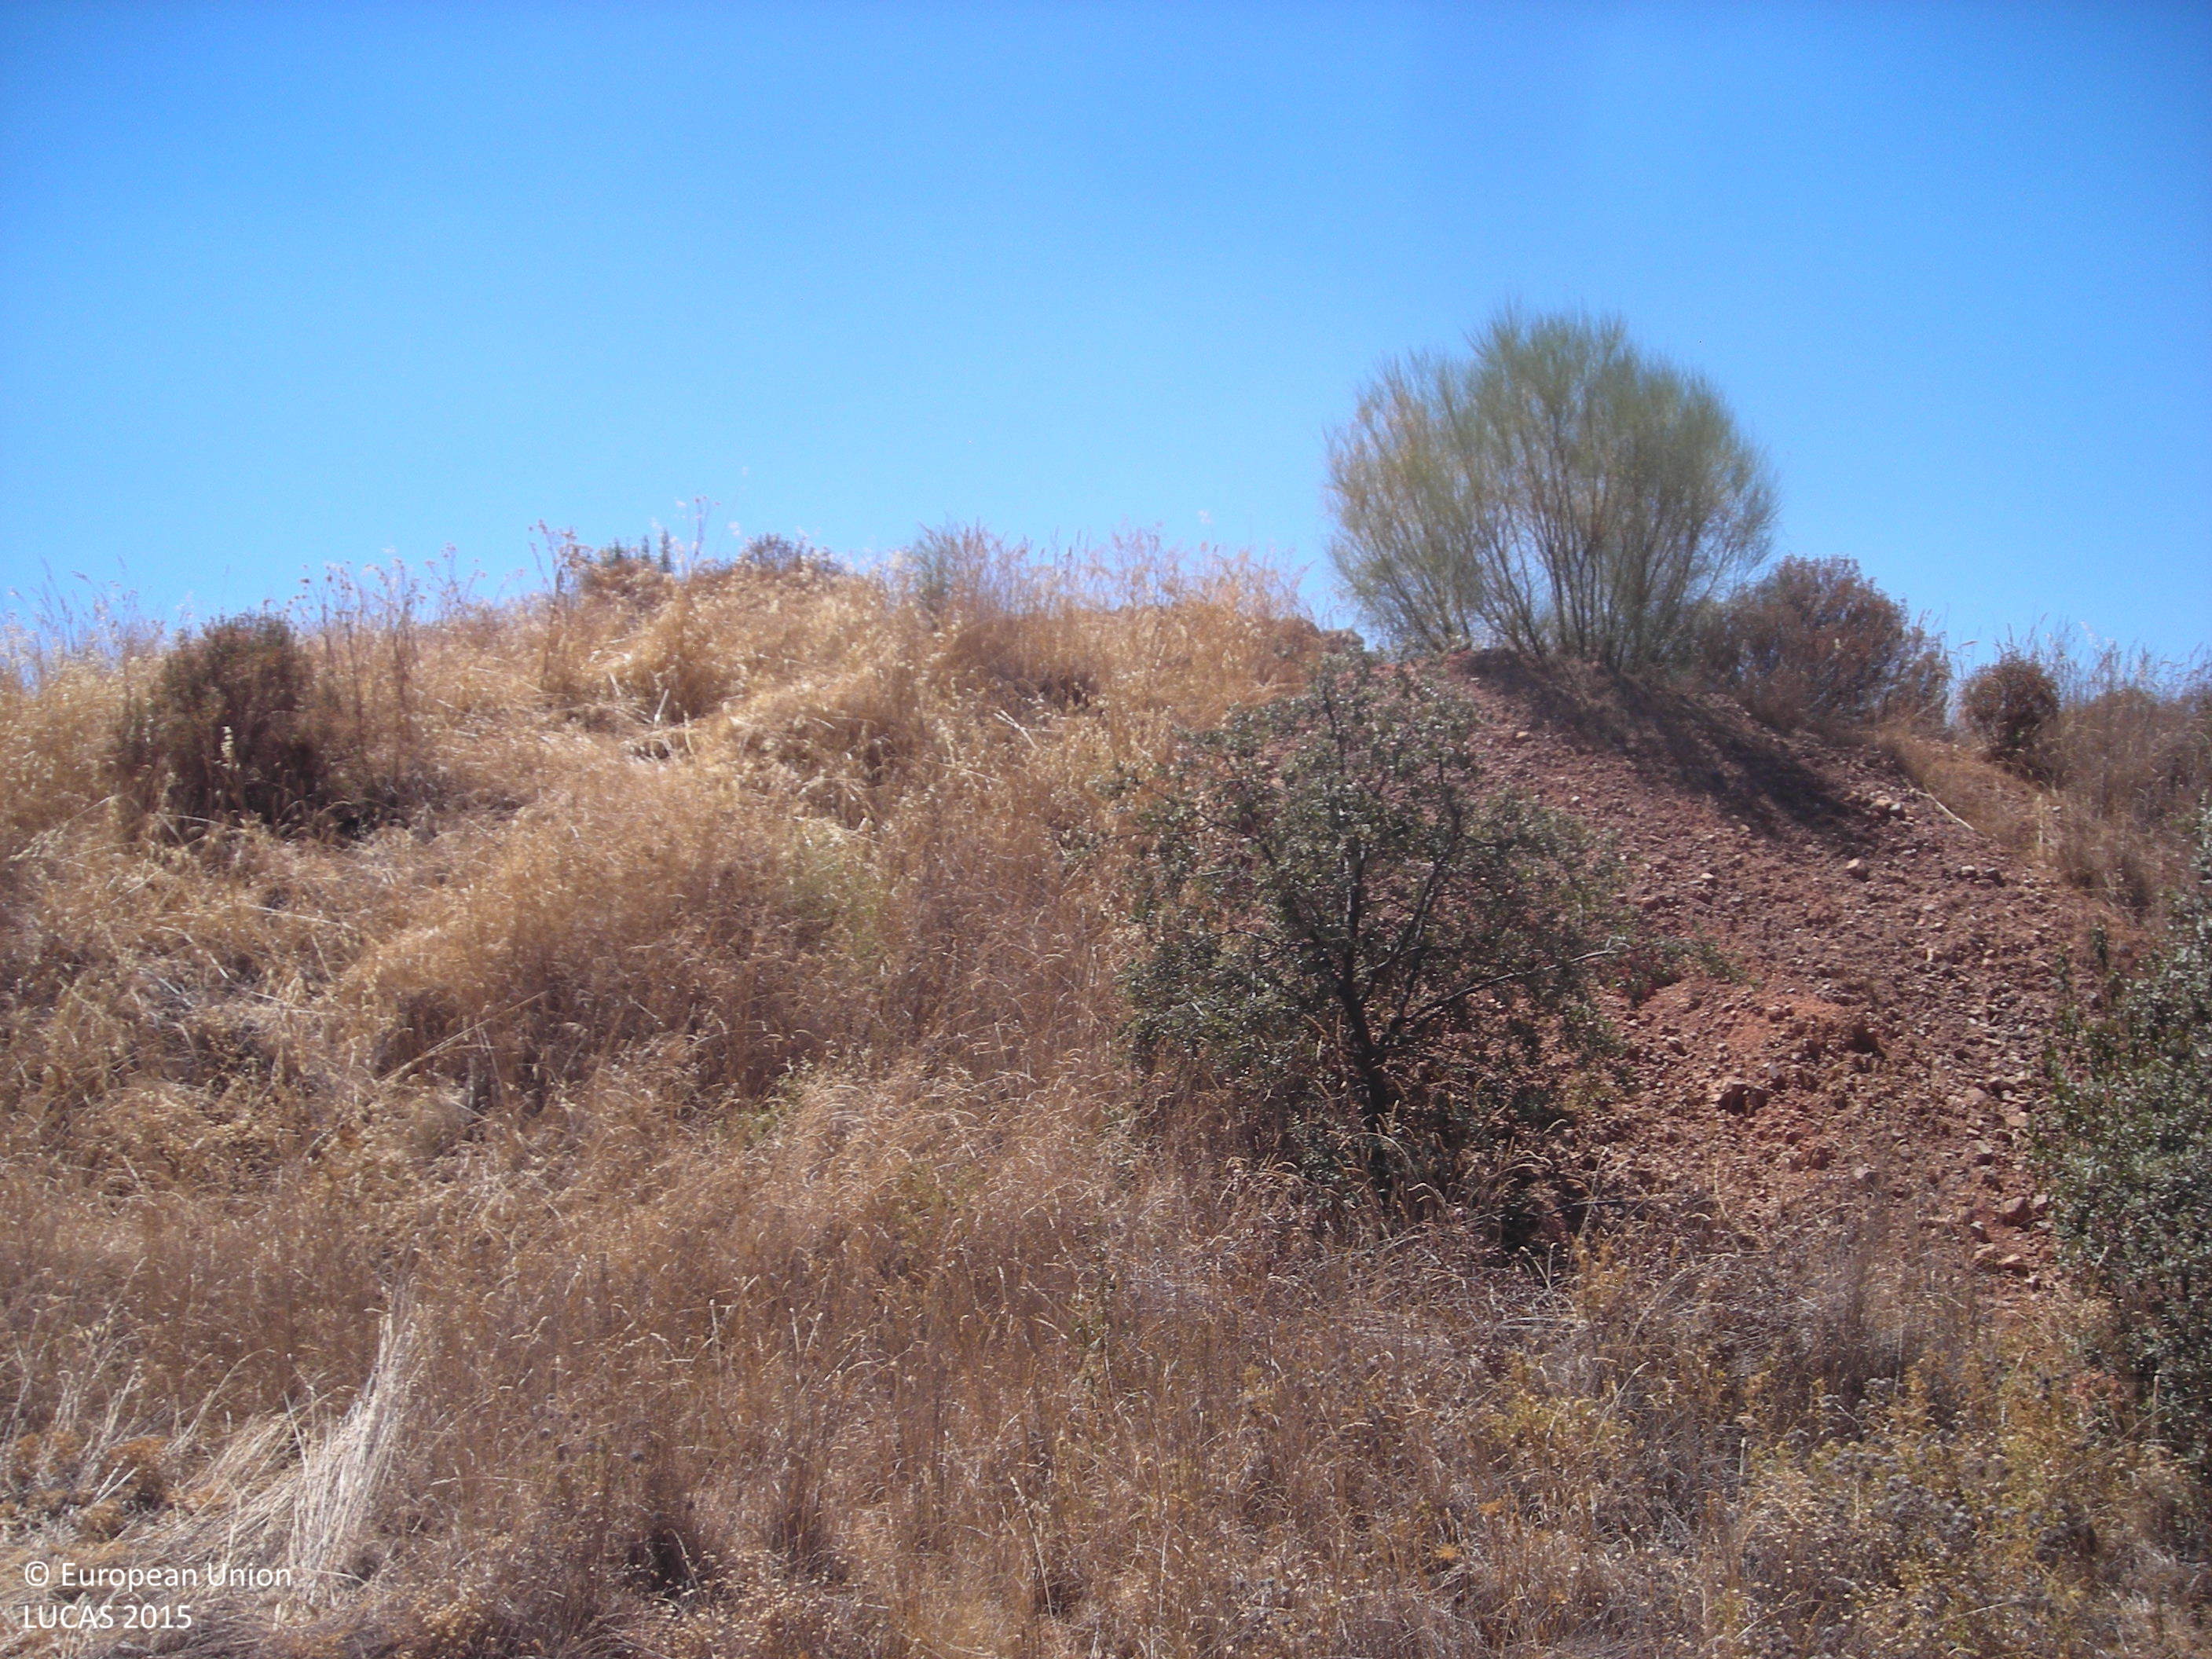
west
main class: Shrubland
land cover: Shrubland with sparse tree cover
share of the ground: > 75 %
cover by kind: shrubs 95 %, broadleaved forest trees 5 %
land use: Semi-natural and natural areas not in use
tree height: > 5 m
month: July
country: ES
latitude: 38.8104
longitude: -5.8114
